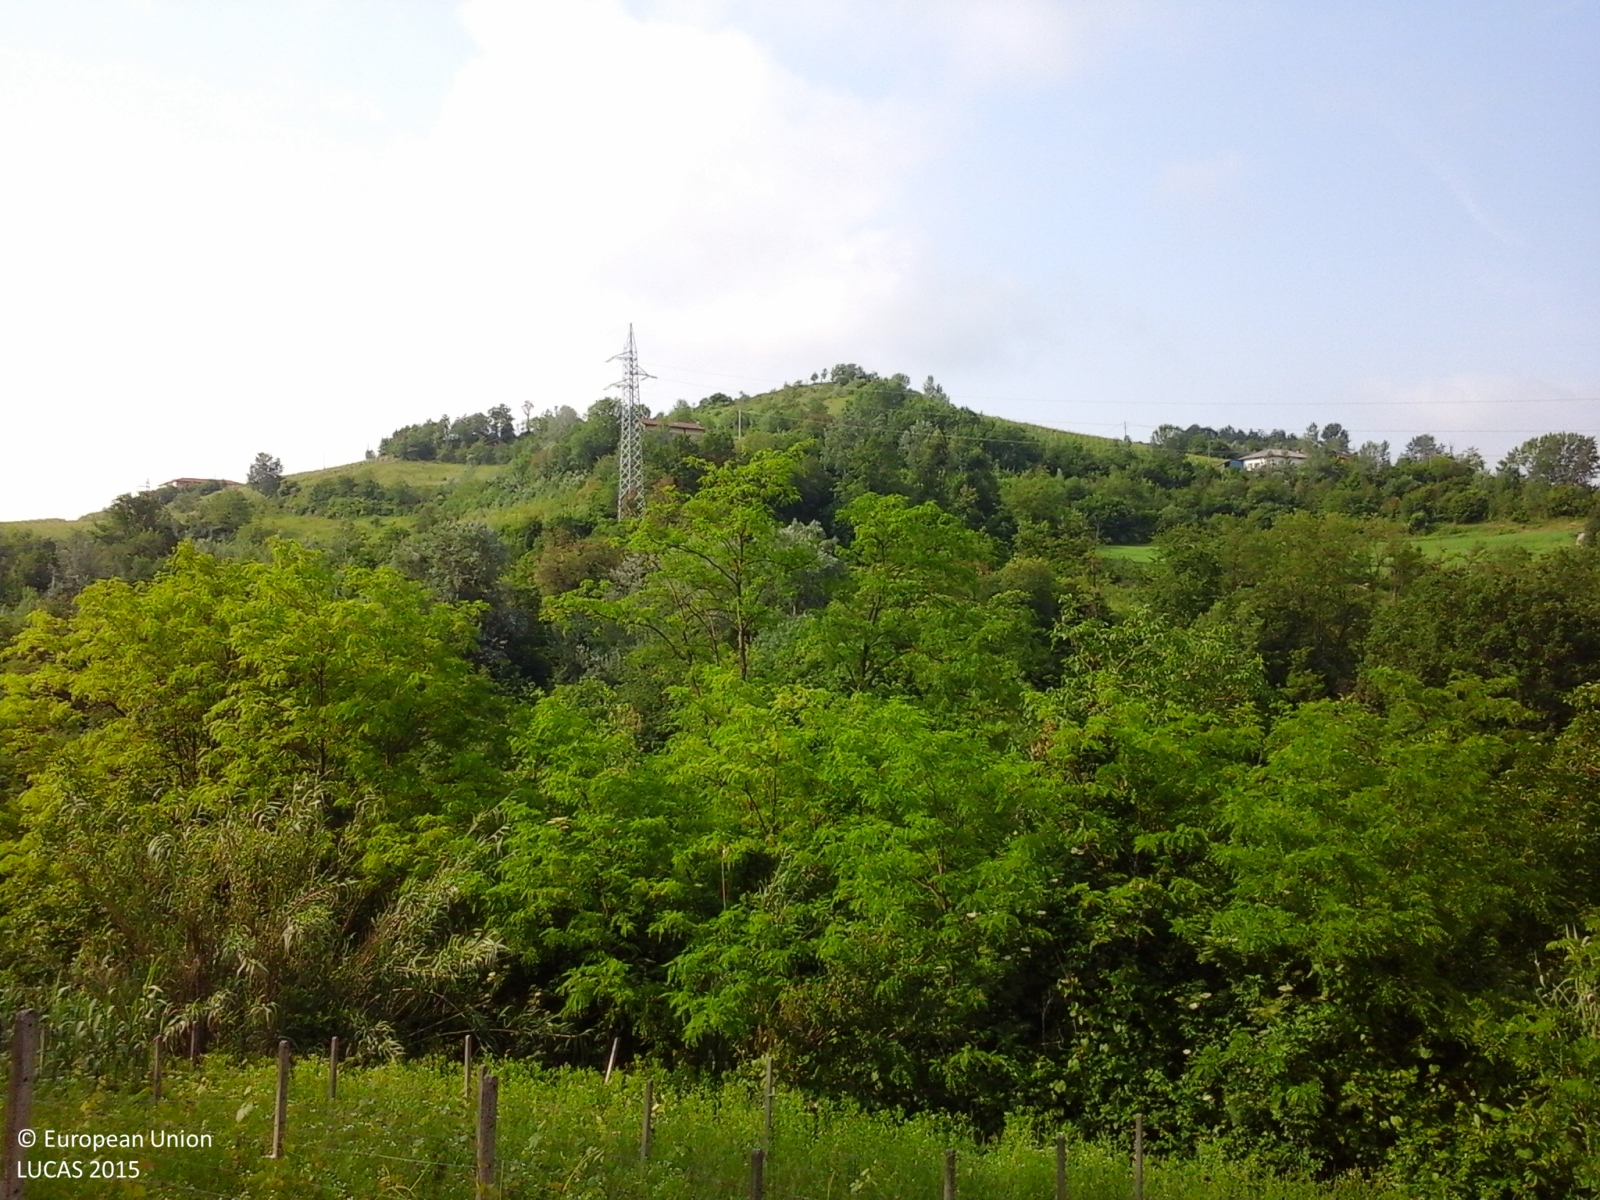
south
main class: Cropland
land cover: Vineyards
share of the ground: 25 - 50 %
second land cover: Grassland without tree/shrub cover
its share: > 75 %
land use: Agriculture (excluding fallow land and kitchen gardens)
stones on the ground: < 10 %
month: May
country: IT
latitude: 44.6982
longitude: 8.3502
